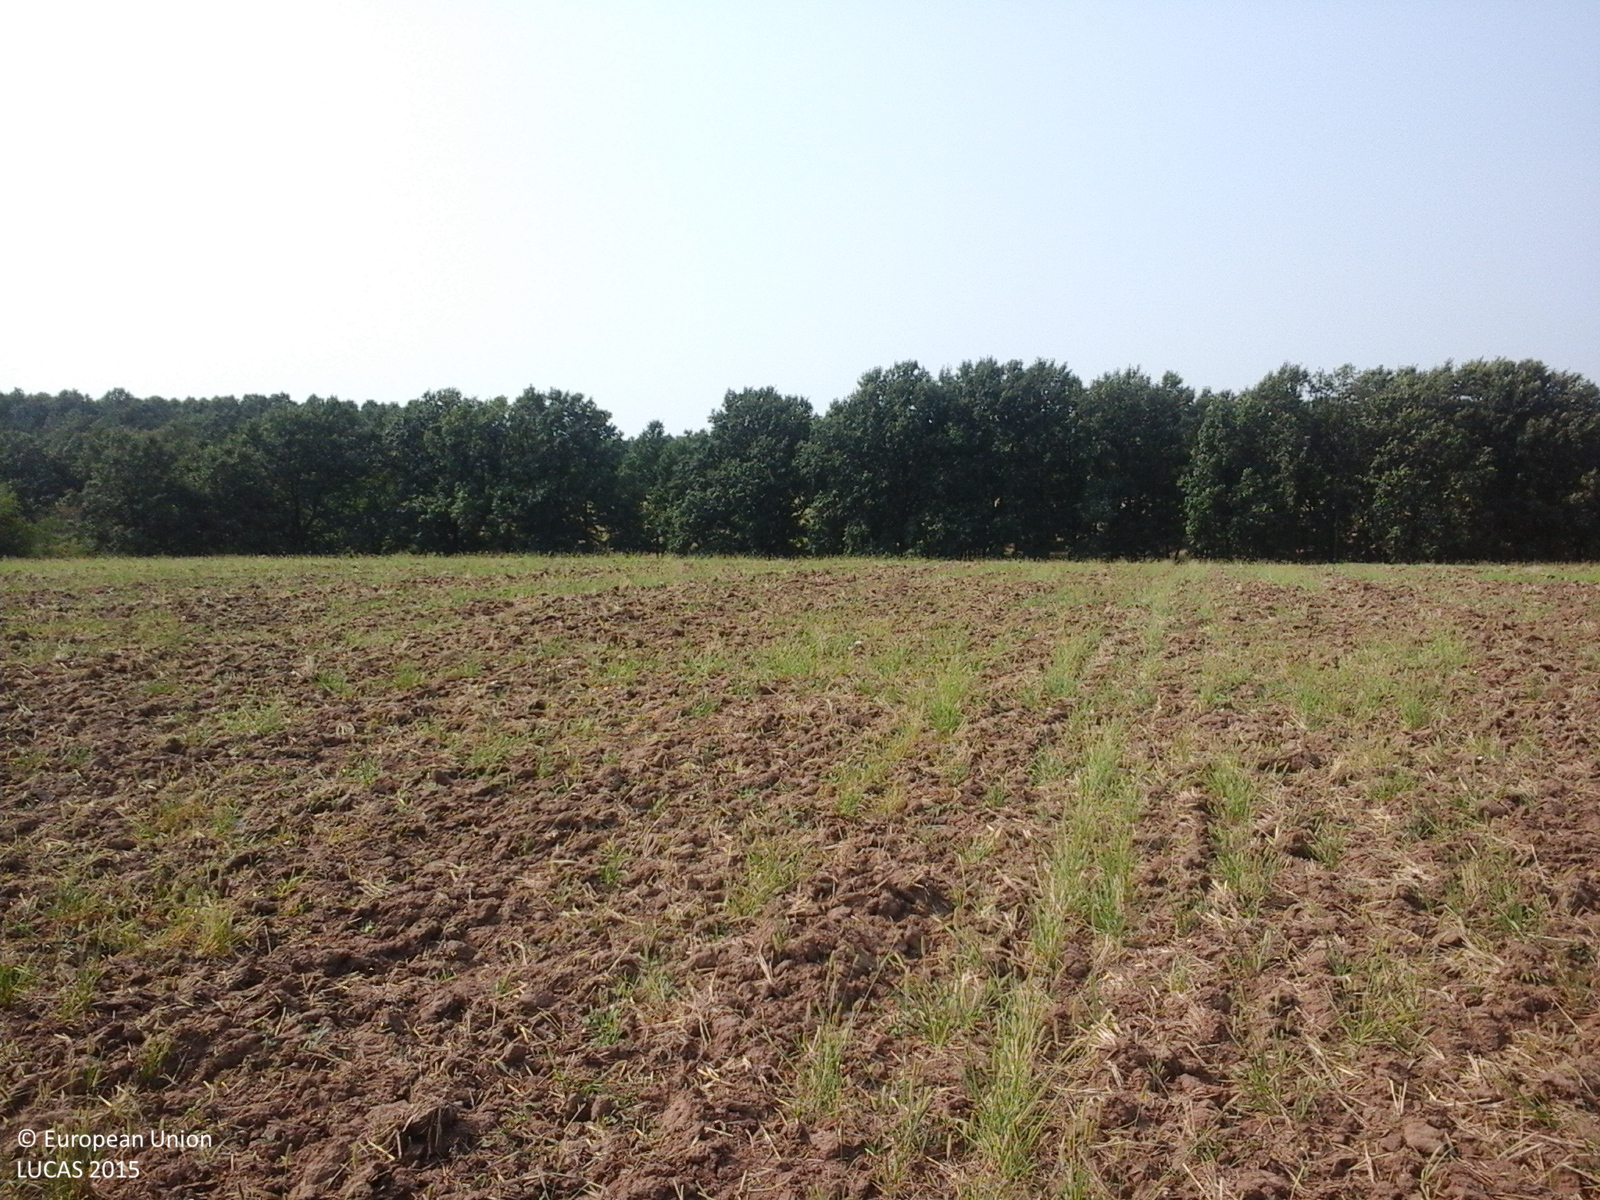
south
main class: Cropland
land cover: Durum wheat
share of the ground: 25 - 50 %
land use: Agriculture (excluding fallow land and kitchen gardens)
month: August
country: RO
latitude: 44.2683
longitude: 23.4933
